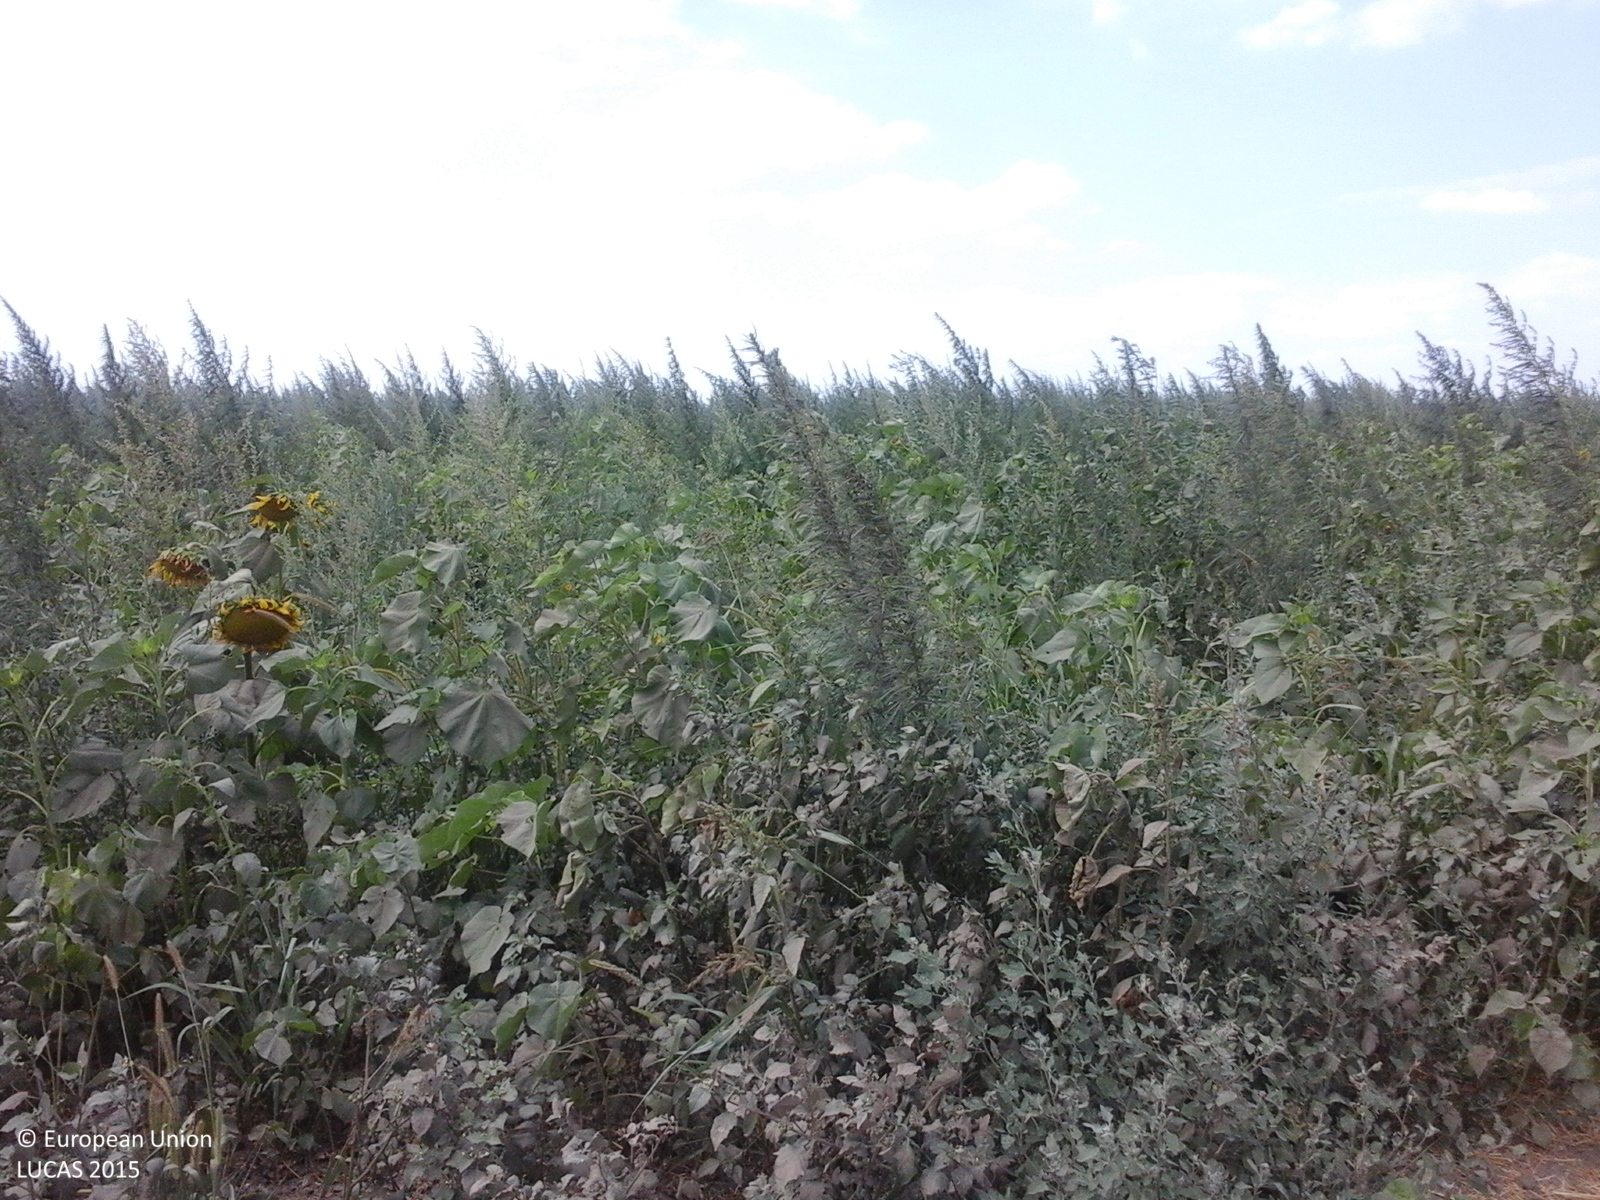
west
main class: Cropland
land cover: Sunflower
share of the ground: 50 - 75 %
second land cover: Spontaneously vegetated surfaces
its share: 25 - 50 %
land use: Agriculture (excluding fallow land and kitchen gardens)
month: August
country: RO
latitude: 45.3126
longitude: 29.0944
